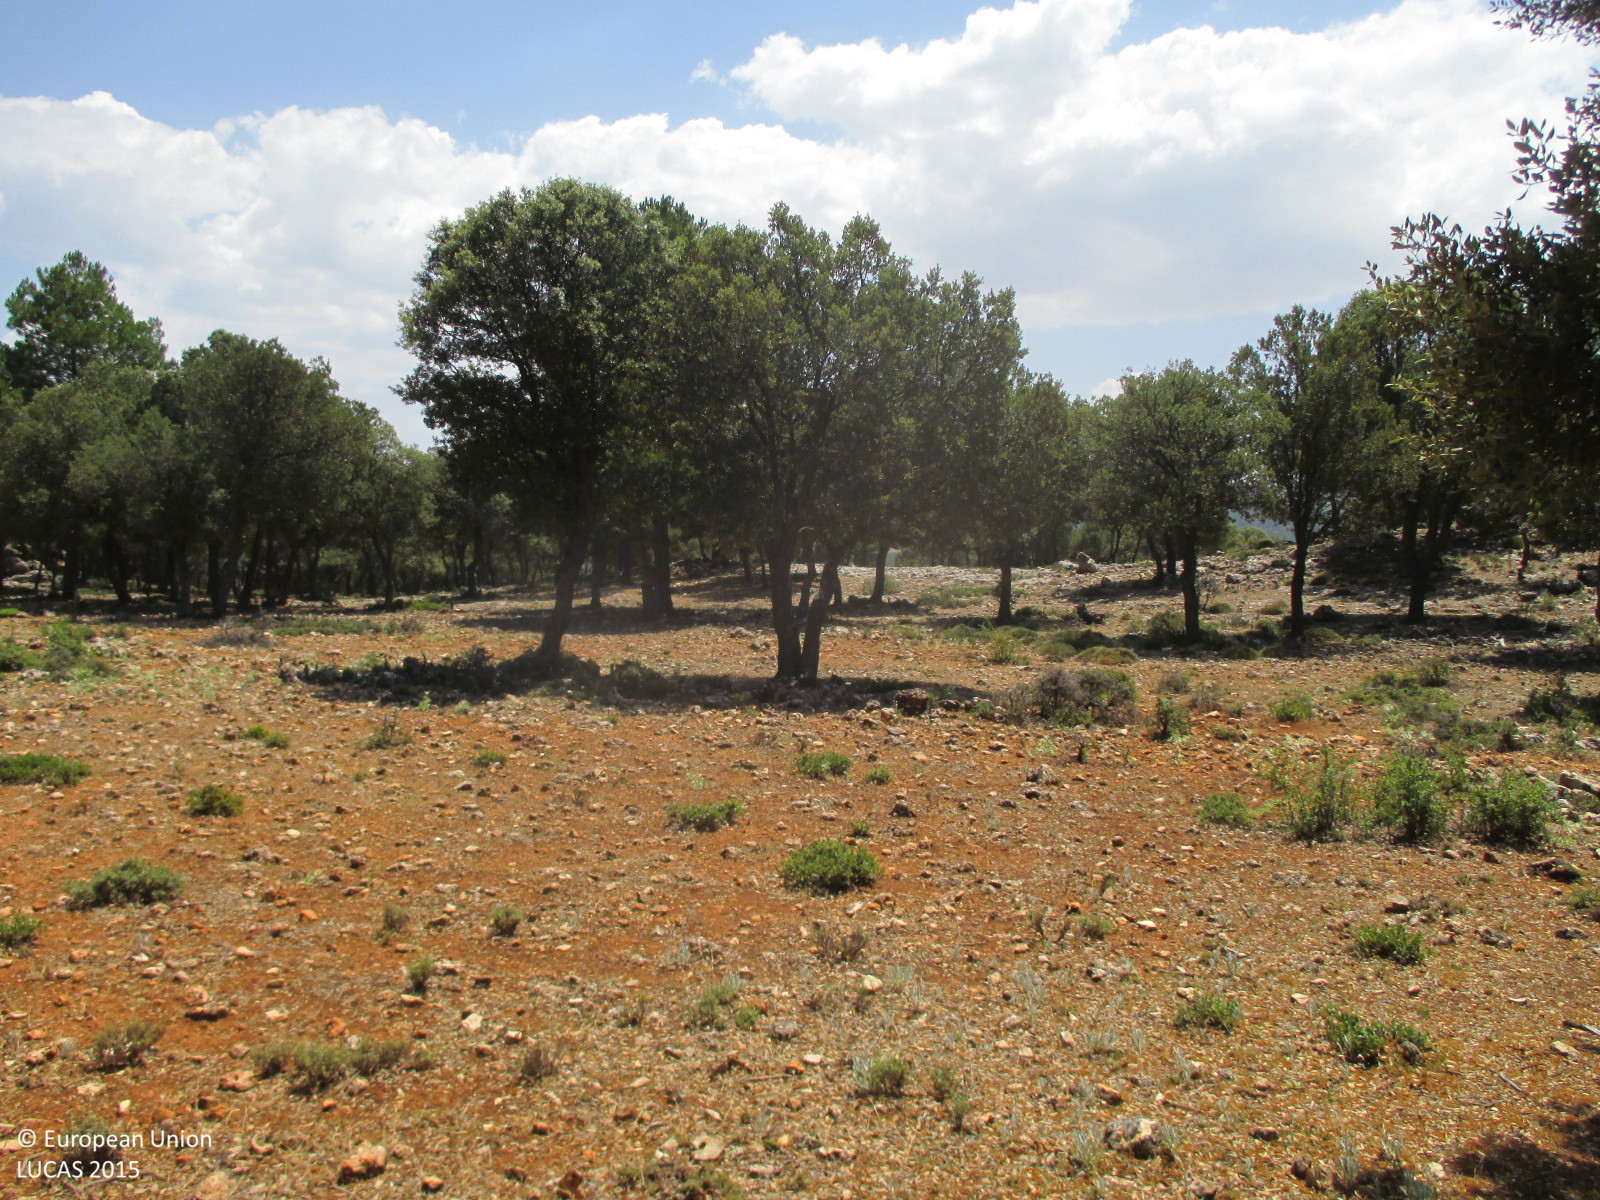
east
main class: Woodland
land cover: Broadleaved woodland
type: broadleaved evergreen forest
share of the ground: > 75 %
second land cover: Grassland without tree/shrub cover
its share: > 75 %
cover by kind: broadleaved forest trees 75 %, herbaceous plants 25 %
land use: Forestry
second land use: Agriculture (excluding fallow land and kitchen gardens)
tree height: > 5 m
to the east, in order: Broadleaved woodland; Grassland without tree/shrub cover; Tracks; Broadleaved woodland
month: July
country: ES
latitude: 38.0887
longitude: -2.5242
